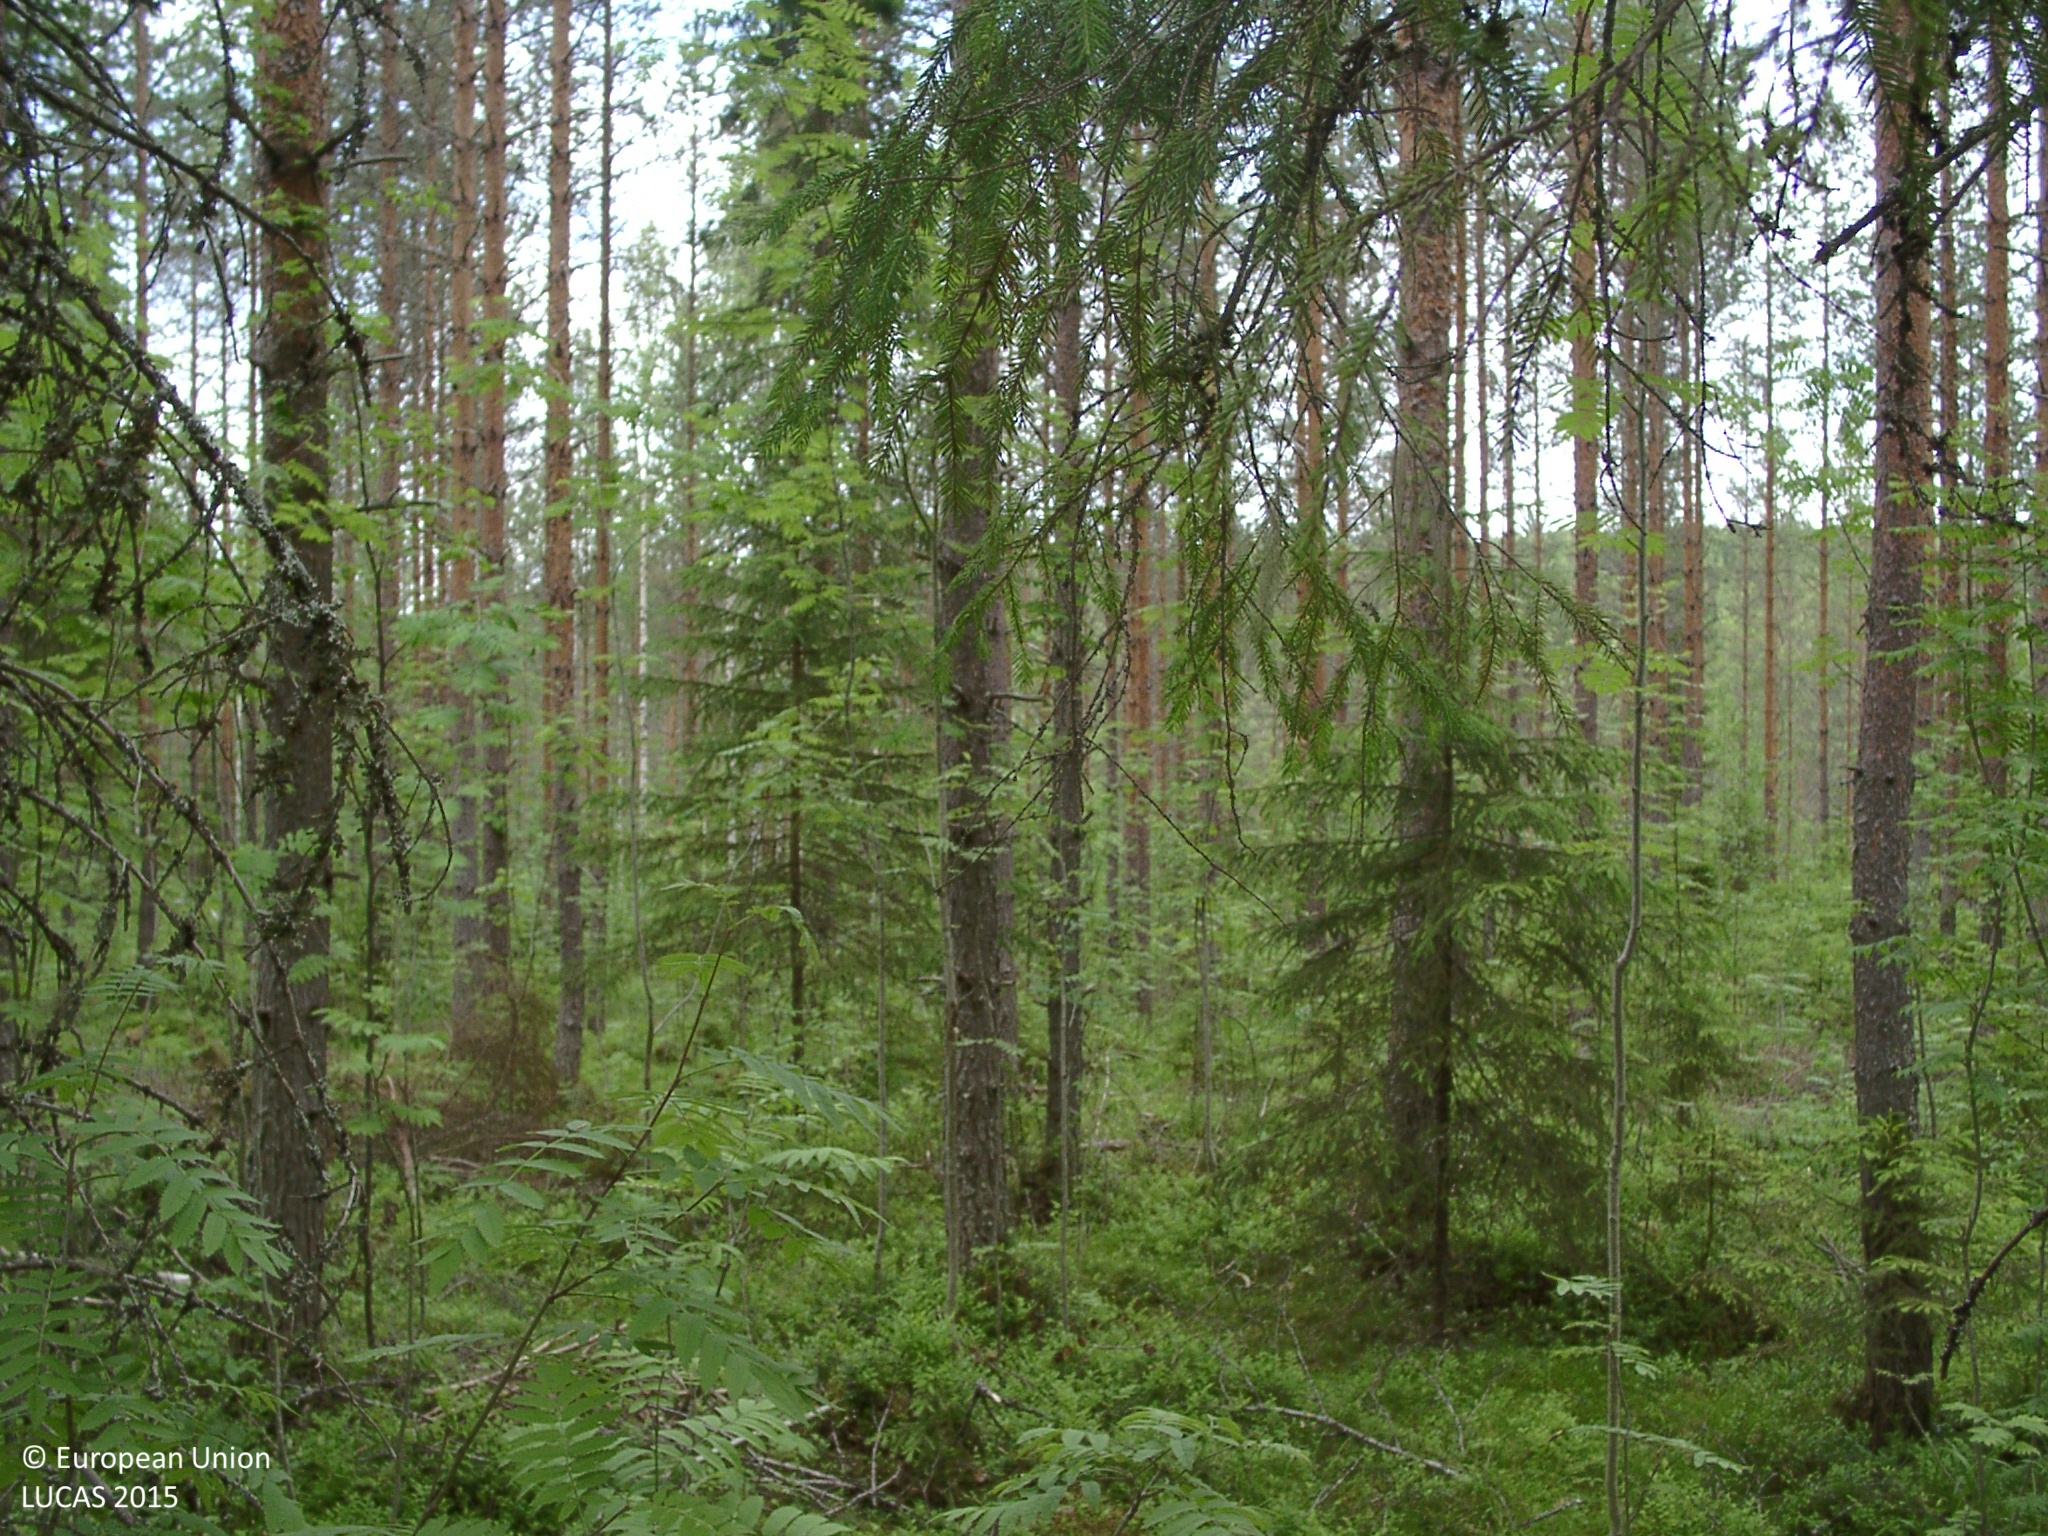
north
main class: Woodland
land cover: Pine dominated coniferous woodland
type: boreal forest
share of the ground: 50 - 75 %
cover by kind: coniferous forest trees 55 %, broadleaved forest trees 15 %, shrubs 15 %, herbaceous plants 10 %, lichens and mosses 5 %
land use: Forestry
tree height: > 5 m
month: July
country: FI
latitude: 62.0530
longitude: 25.3961
